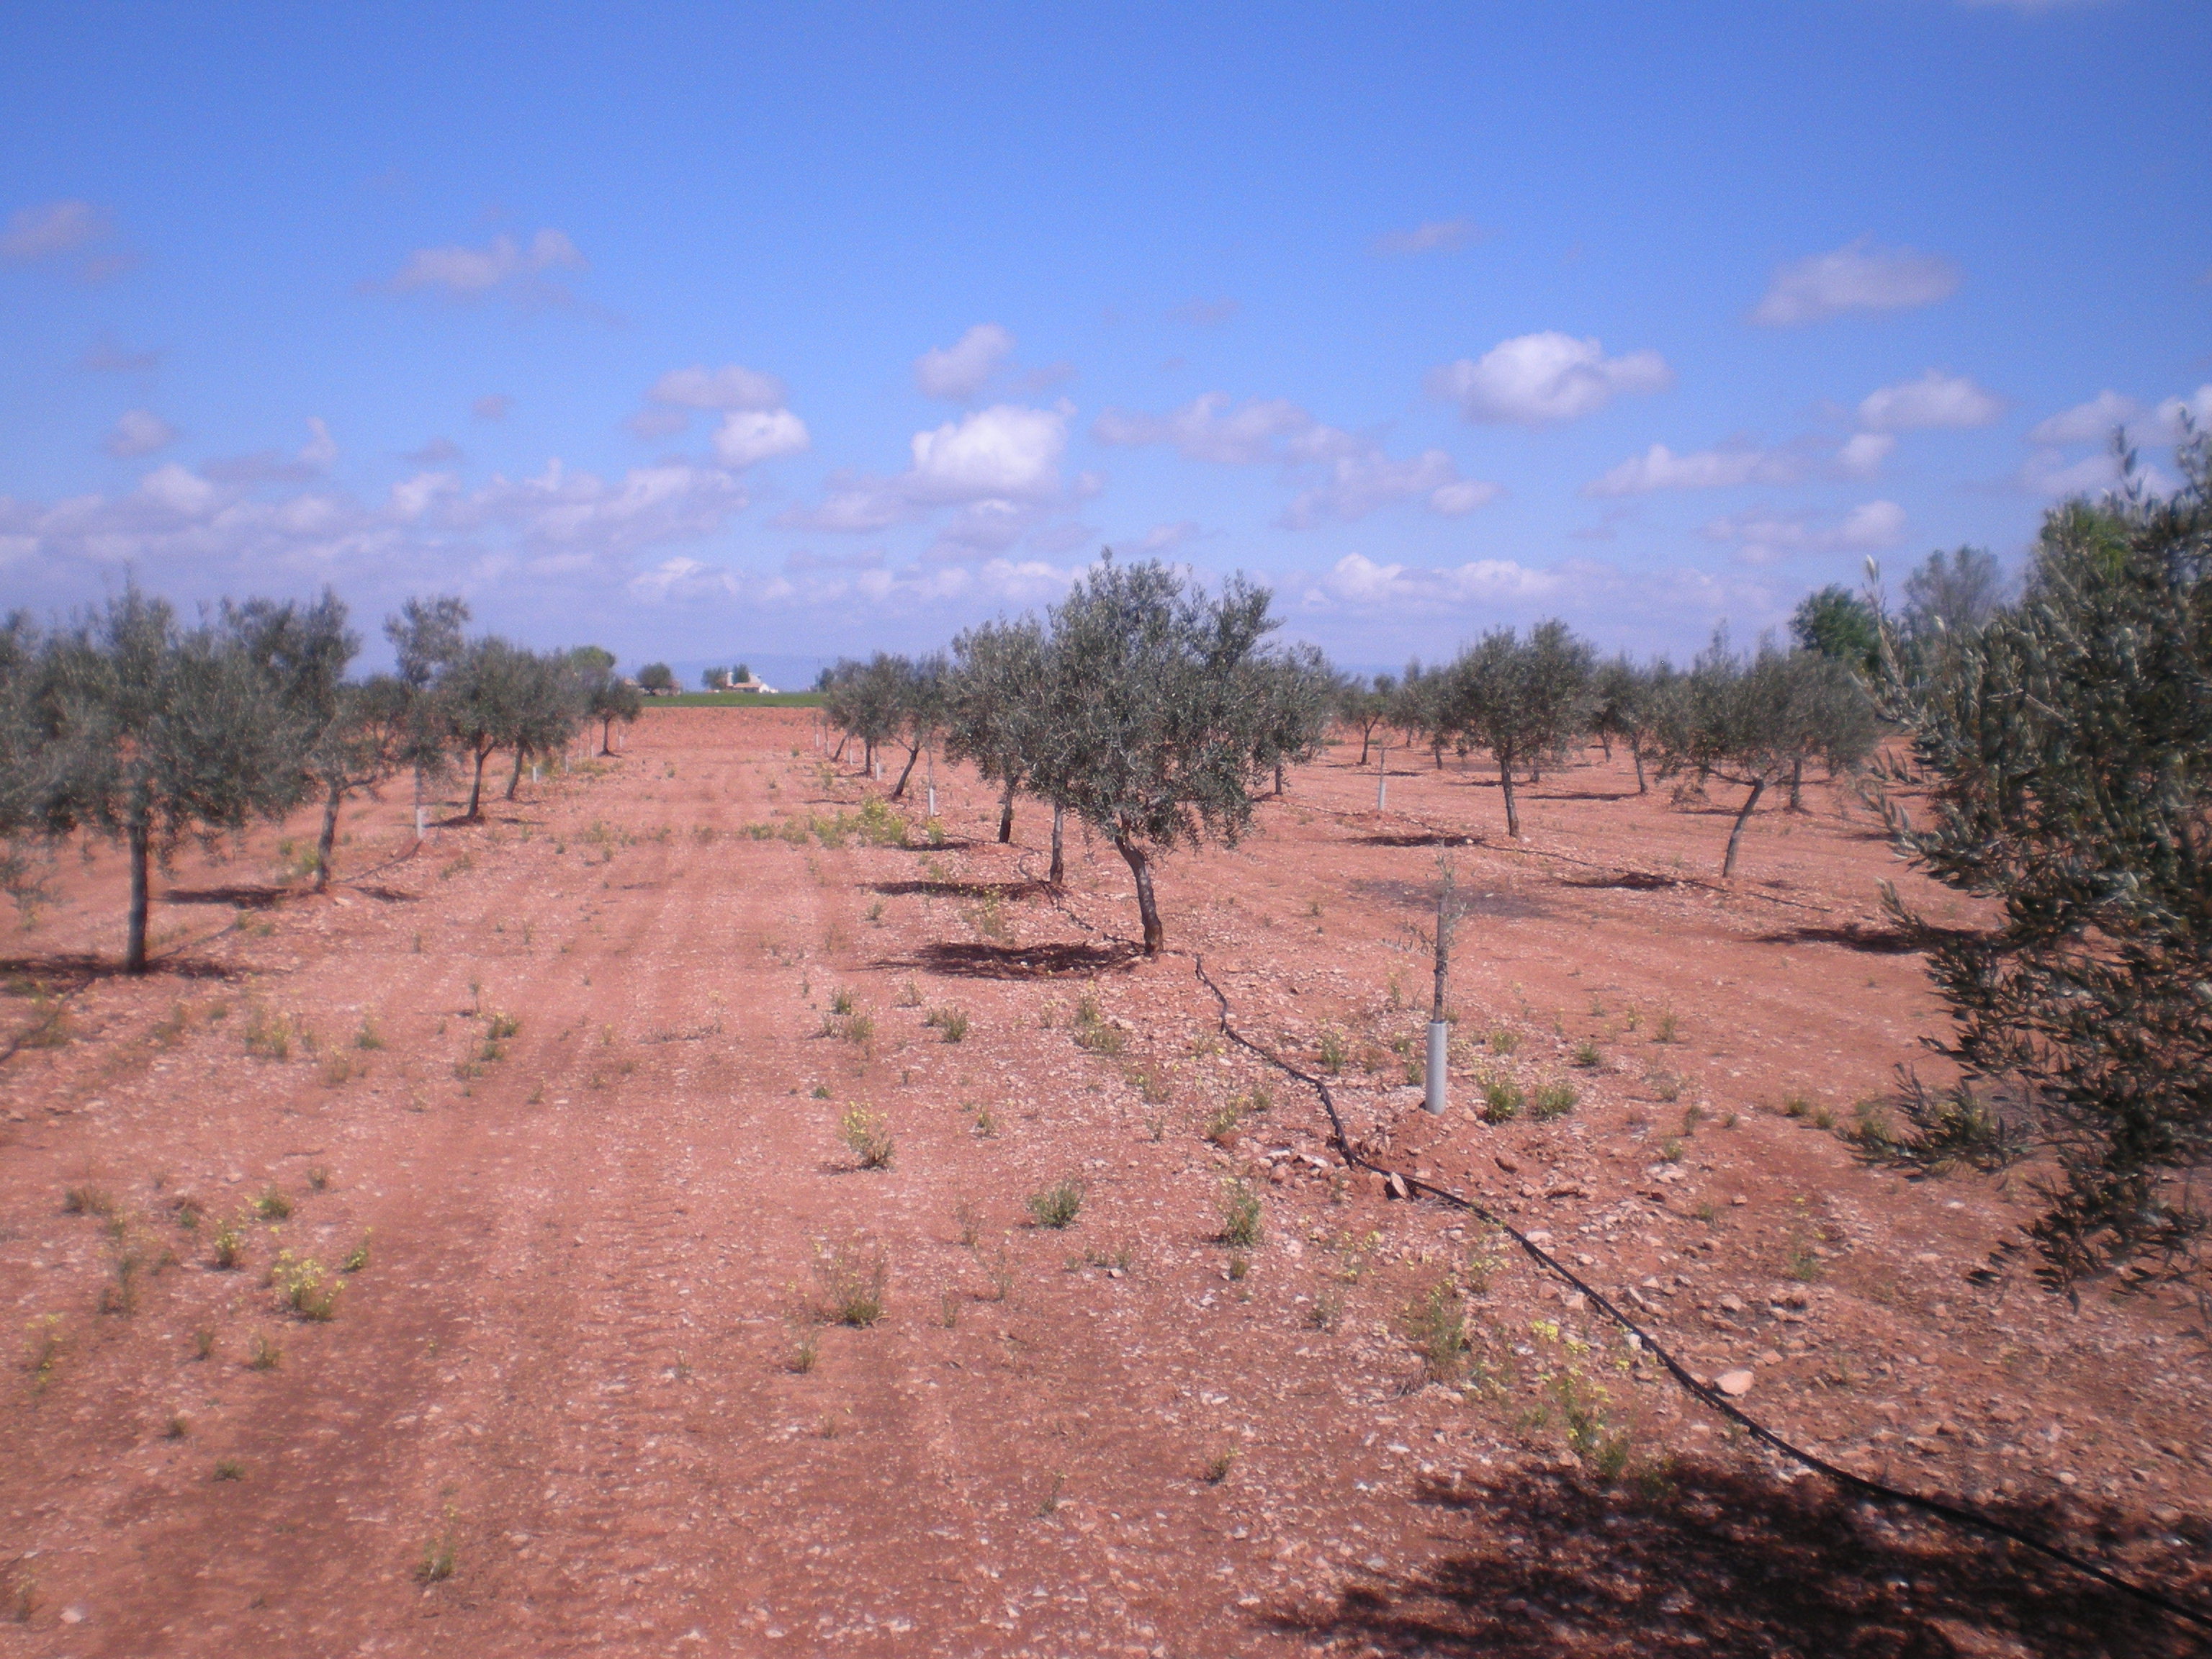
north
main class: Cropland
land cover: Olive groves
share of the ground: < 10 %
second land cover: Other bare soil
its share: > 75 %
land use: Agriculture (excluding fallow land and kitchen gardens)
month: April
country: ES
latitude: 38.9494
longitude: -3.5968
